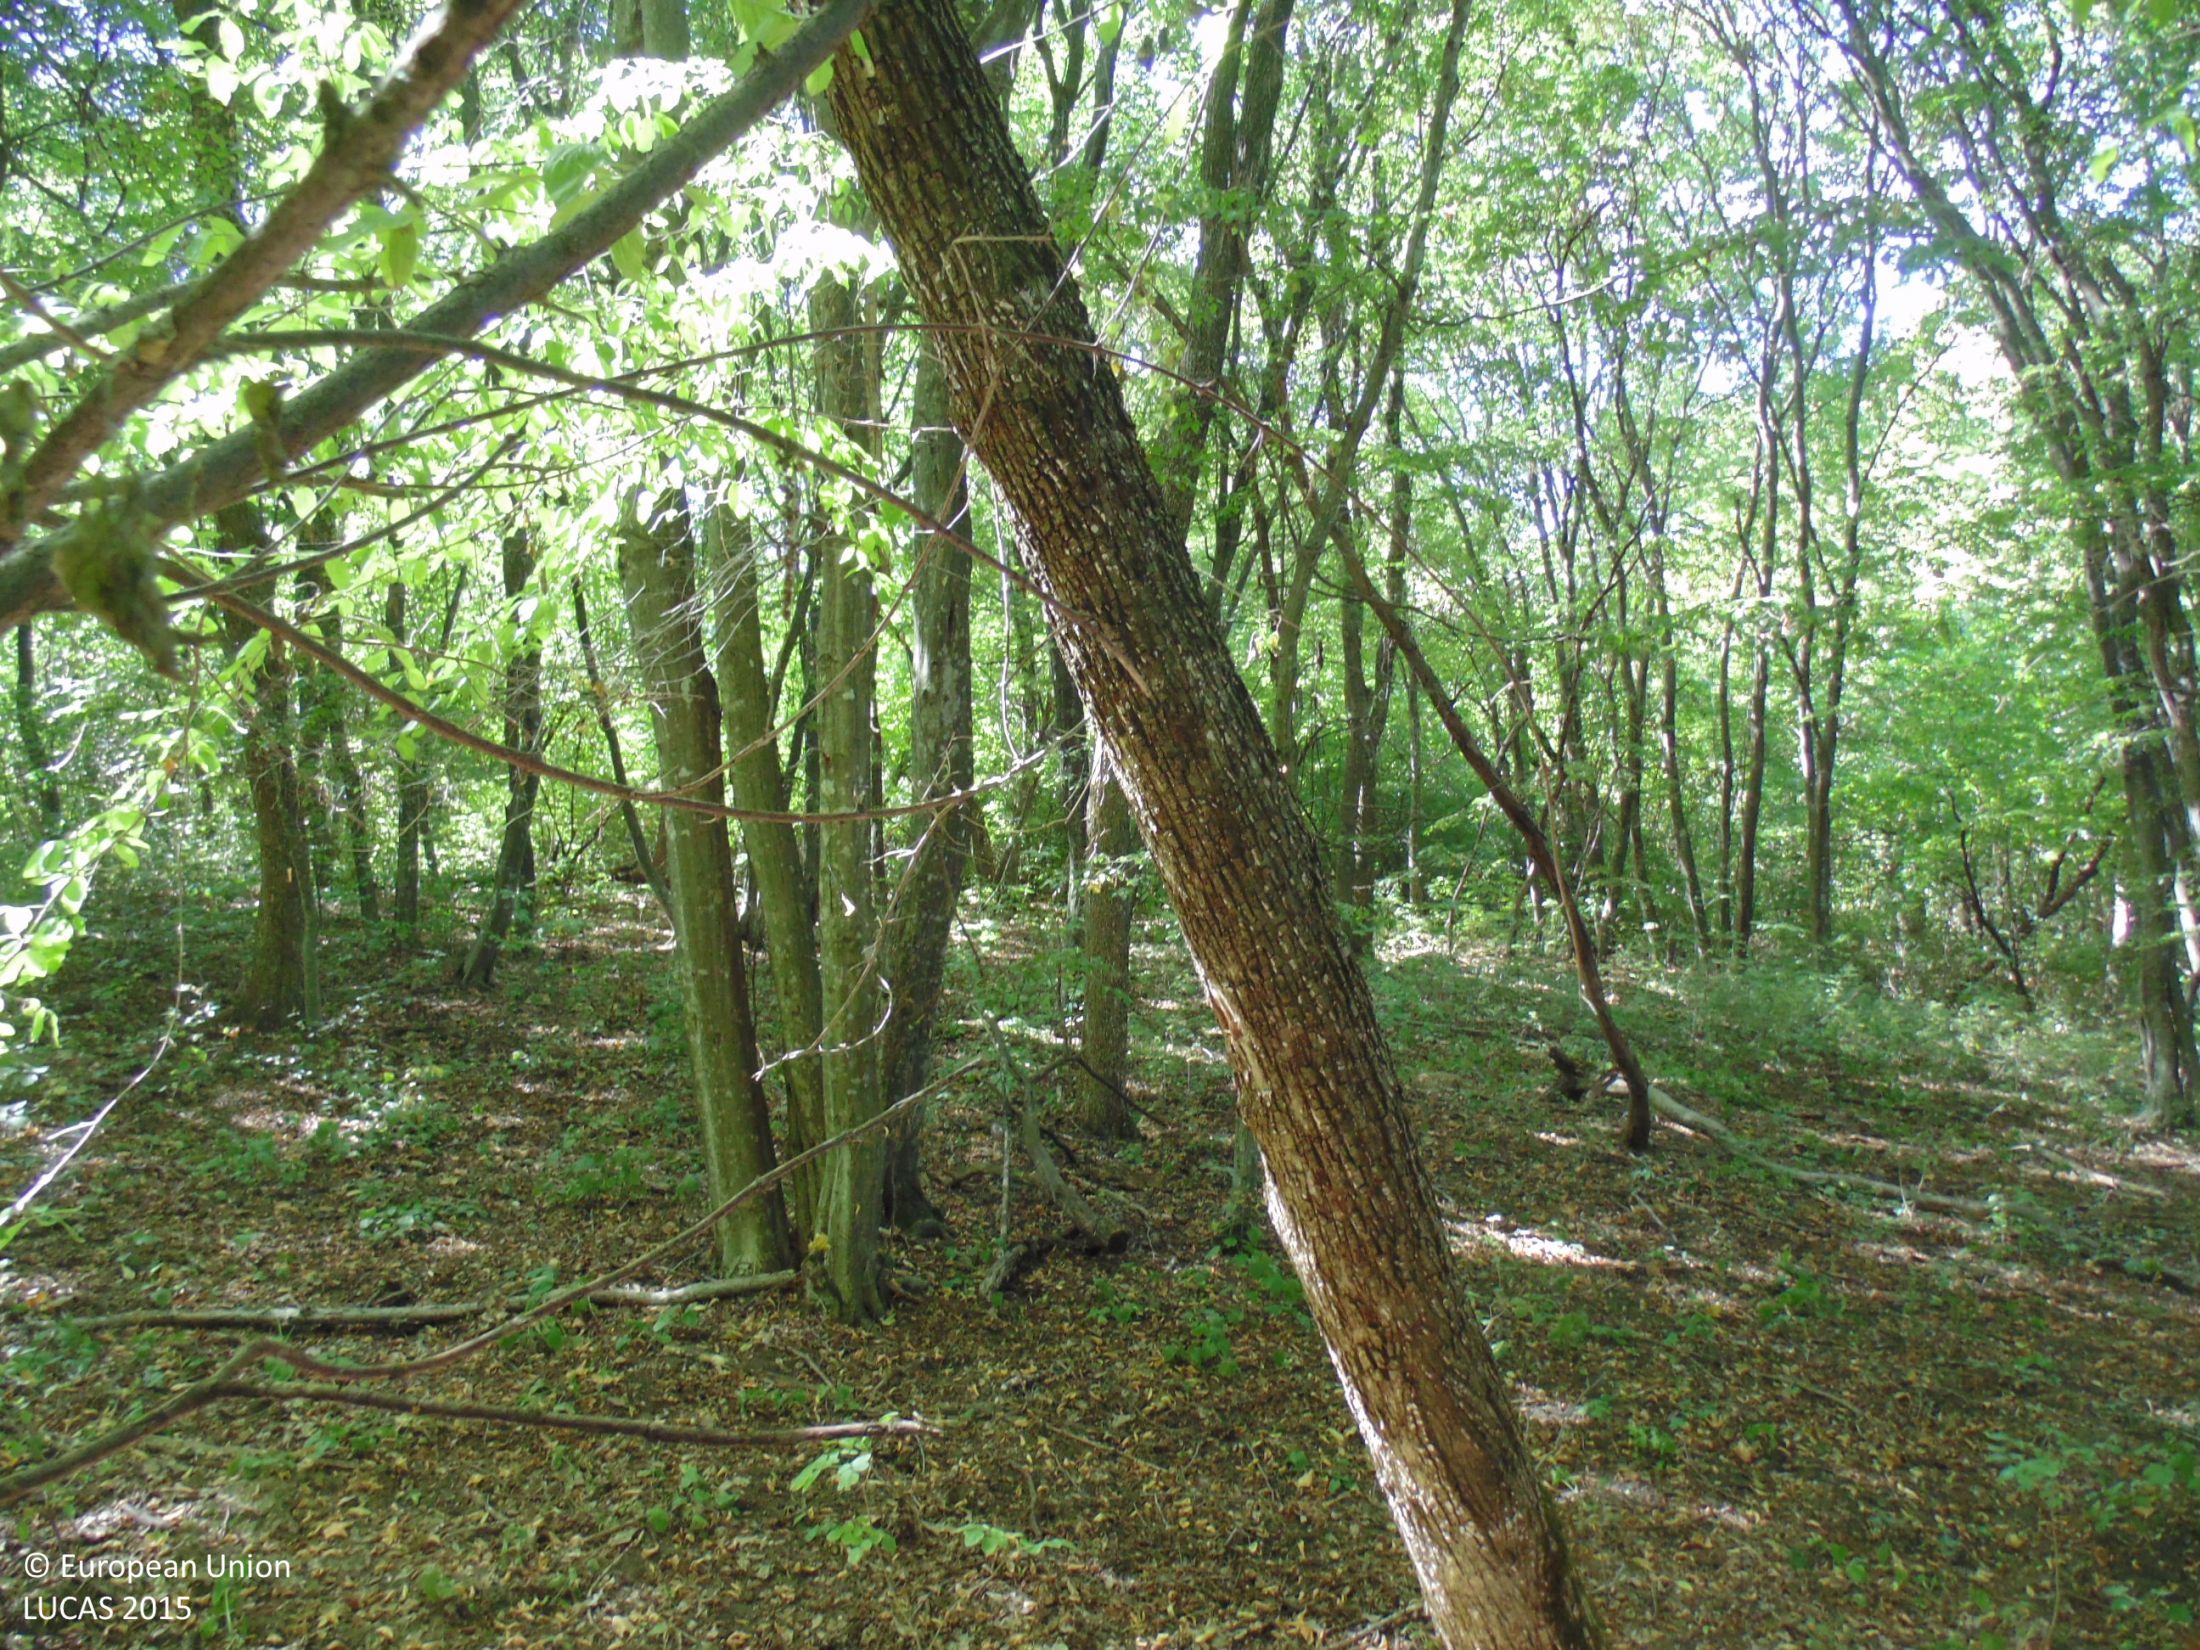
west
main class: Woodland
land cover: Broadleaved woodland
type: mesophytic deciduous forest
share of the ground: > 75 %
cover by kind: broadleaved forest trees 95 %, unconsolidated bare surface 5 %
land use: Forestry
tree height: > 5 m
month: September
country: BG
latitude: 43.8682
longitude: 27.0332
